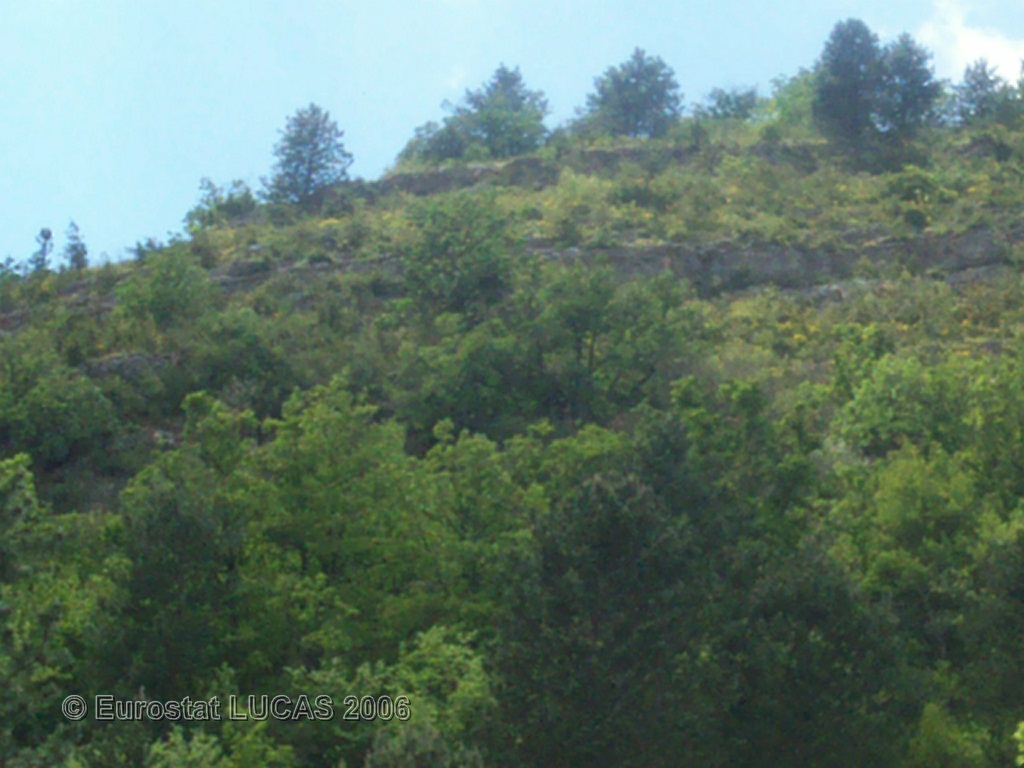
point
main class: Woodland
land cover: Mixed forest
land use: Unused
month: June
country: FR
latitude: 44.4616
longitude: 3.3310
